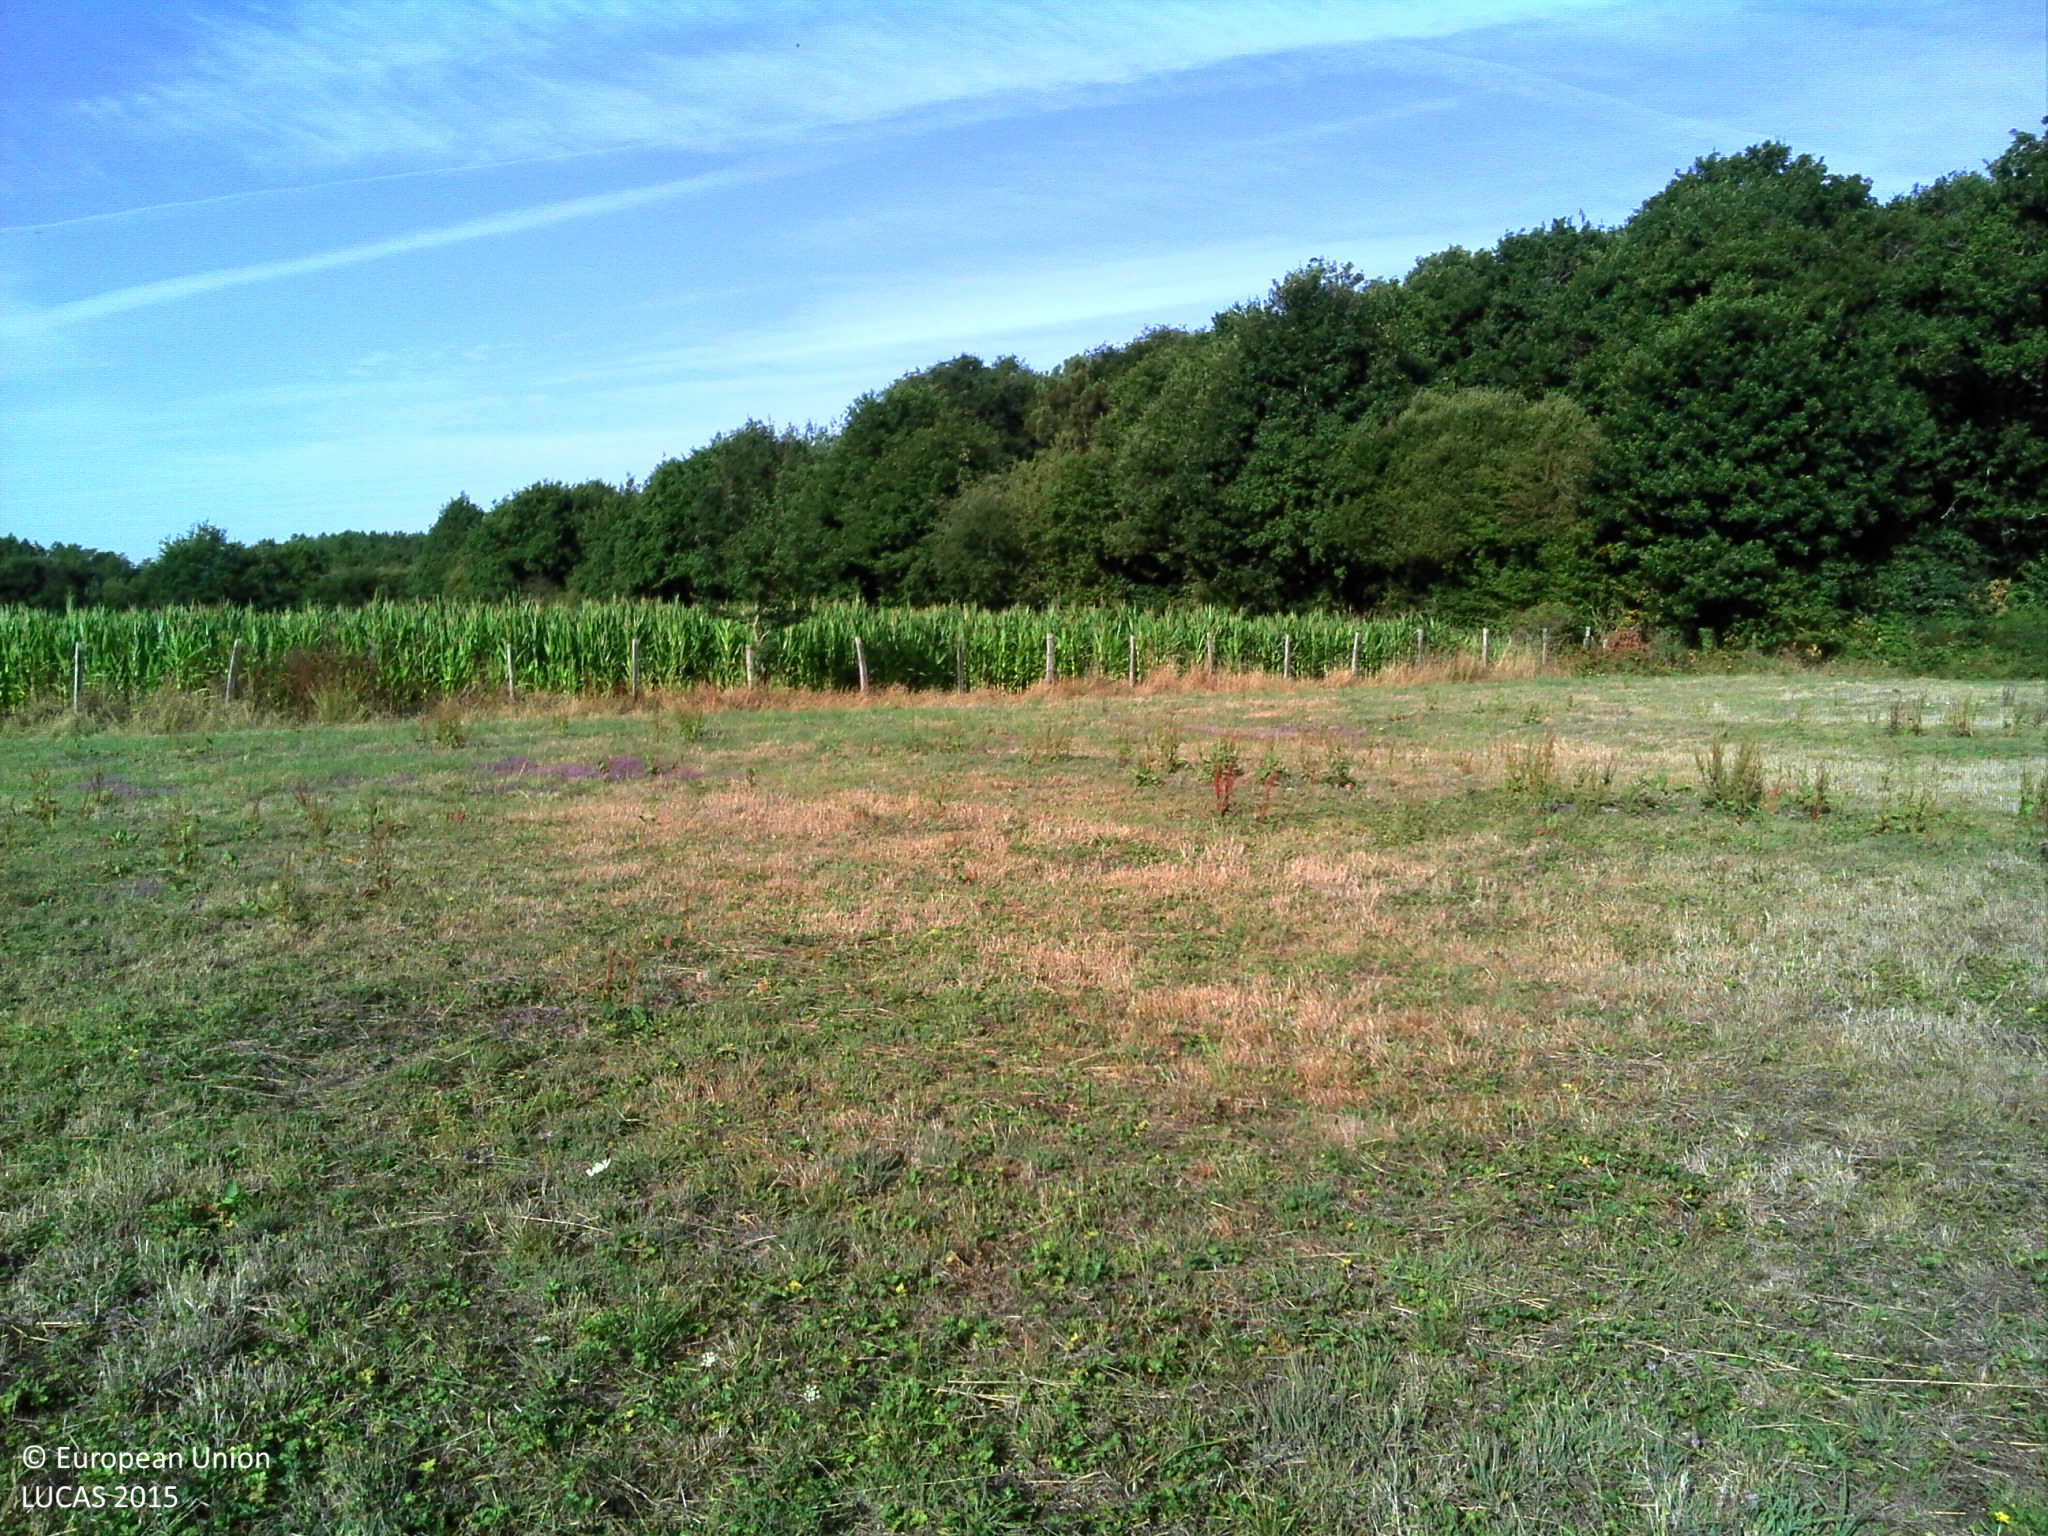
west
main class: Cropland
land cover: Temporary grasslands
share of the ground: > 75 %
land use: Agriculture (excluding fallow land and kitchen gardens)
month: August
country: FR
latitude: 47.4897
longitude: -1.5239
